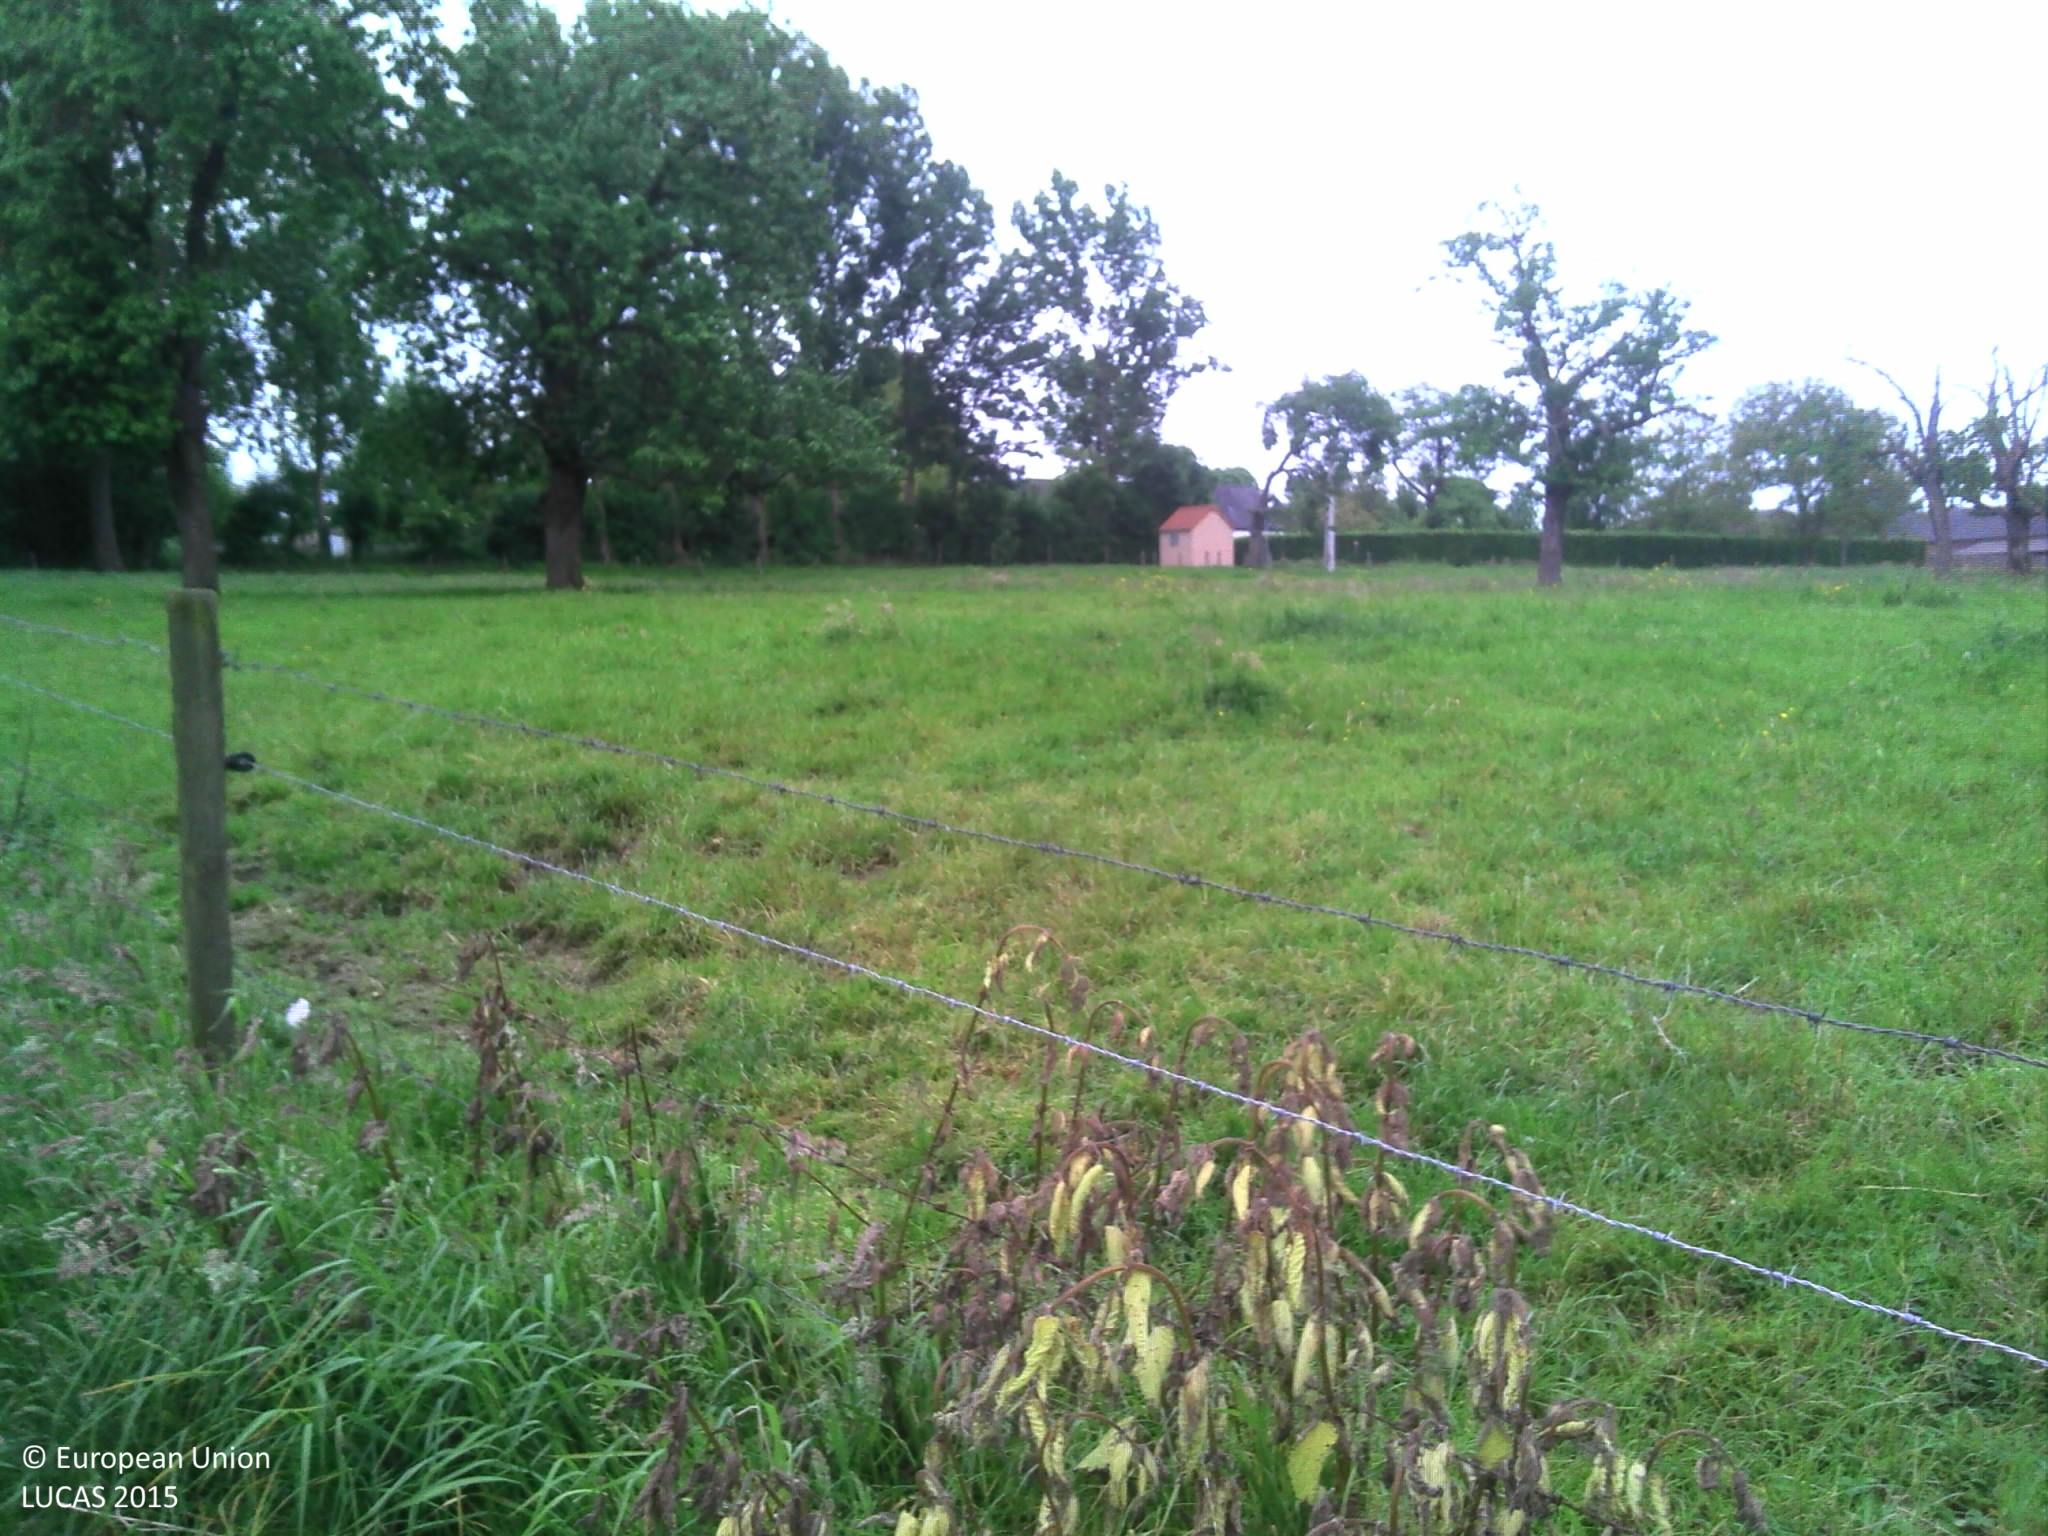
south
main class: Grassland
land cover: Grassland without tree/shrub cover
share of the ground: > 75 %
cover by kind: herbaceous plants 100 %
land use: Residential
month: June
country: BE
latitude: 50.8398
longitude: 3.7021
